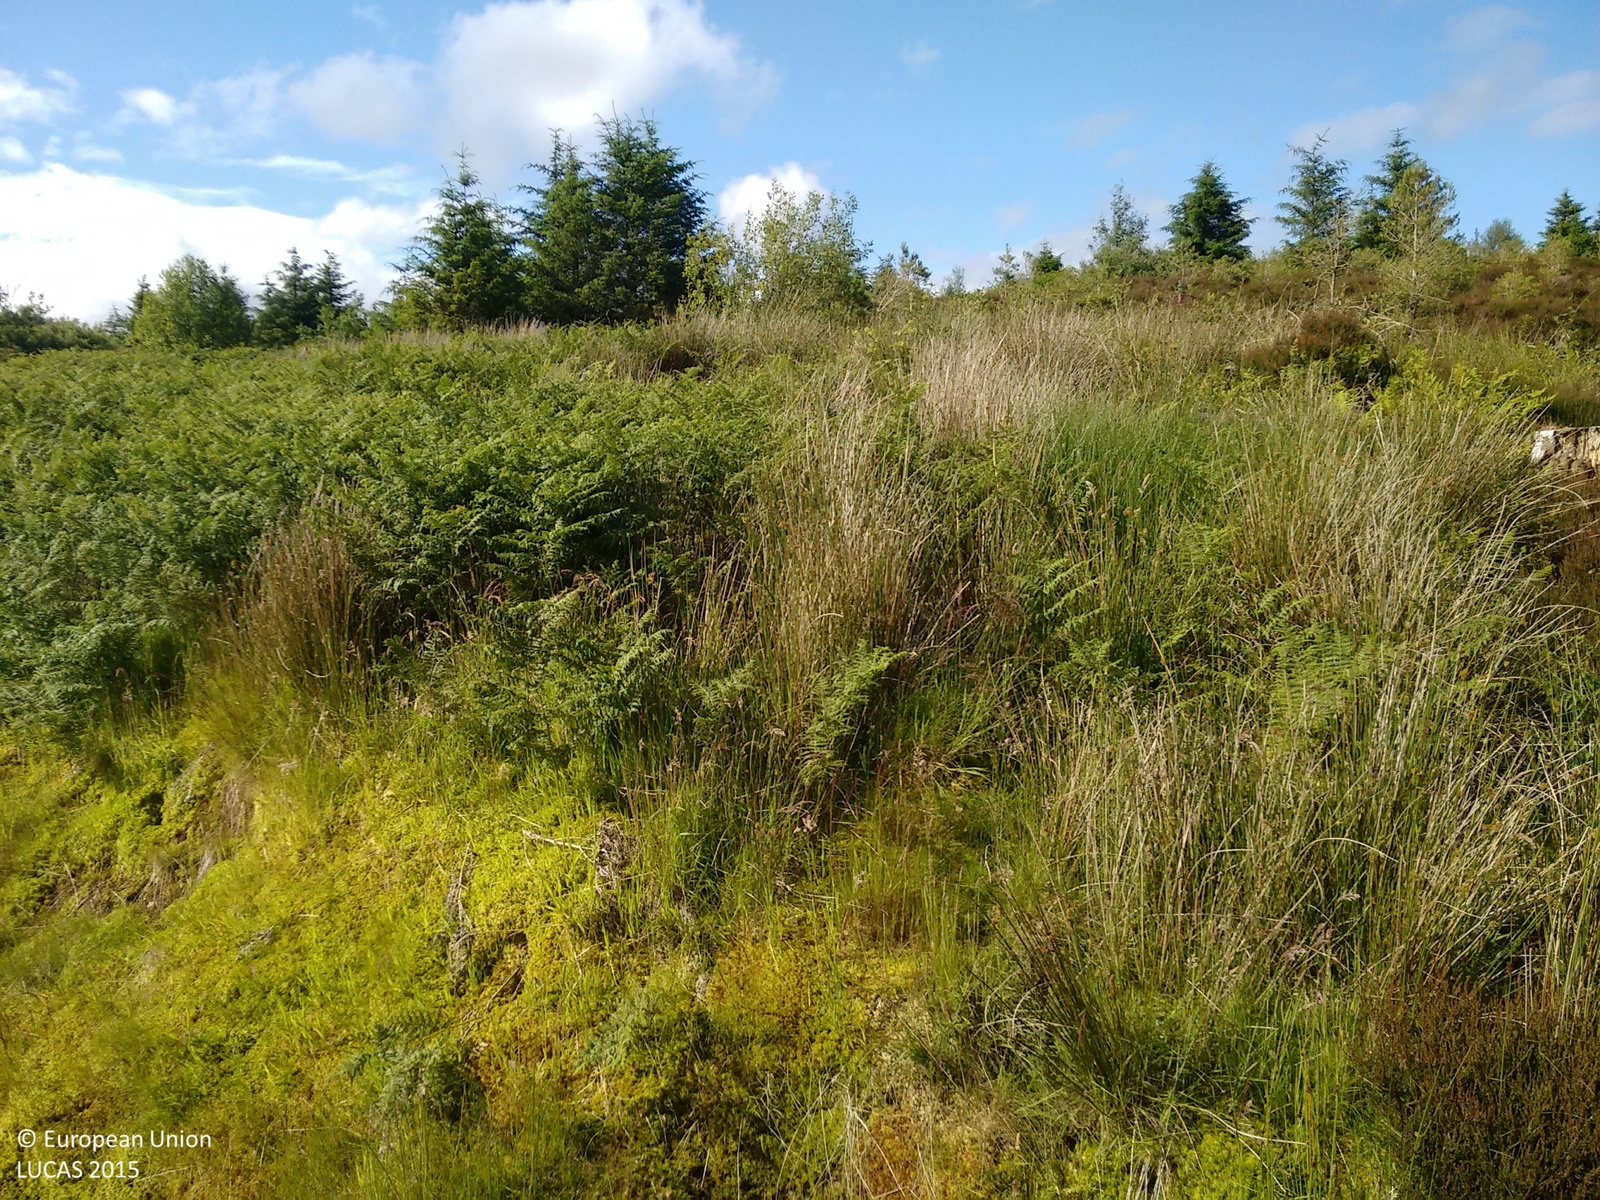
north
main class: Shrubland
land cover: Shrubland with sparse tree cover
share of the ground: > 75 %
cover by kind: shrubs 95 %, coniferous forest trees 5 %
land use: Semi-natural and natural areas not in use
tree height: < 5 m
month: July
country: GB
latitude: 55.4768
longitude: -5.1945
